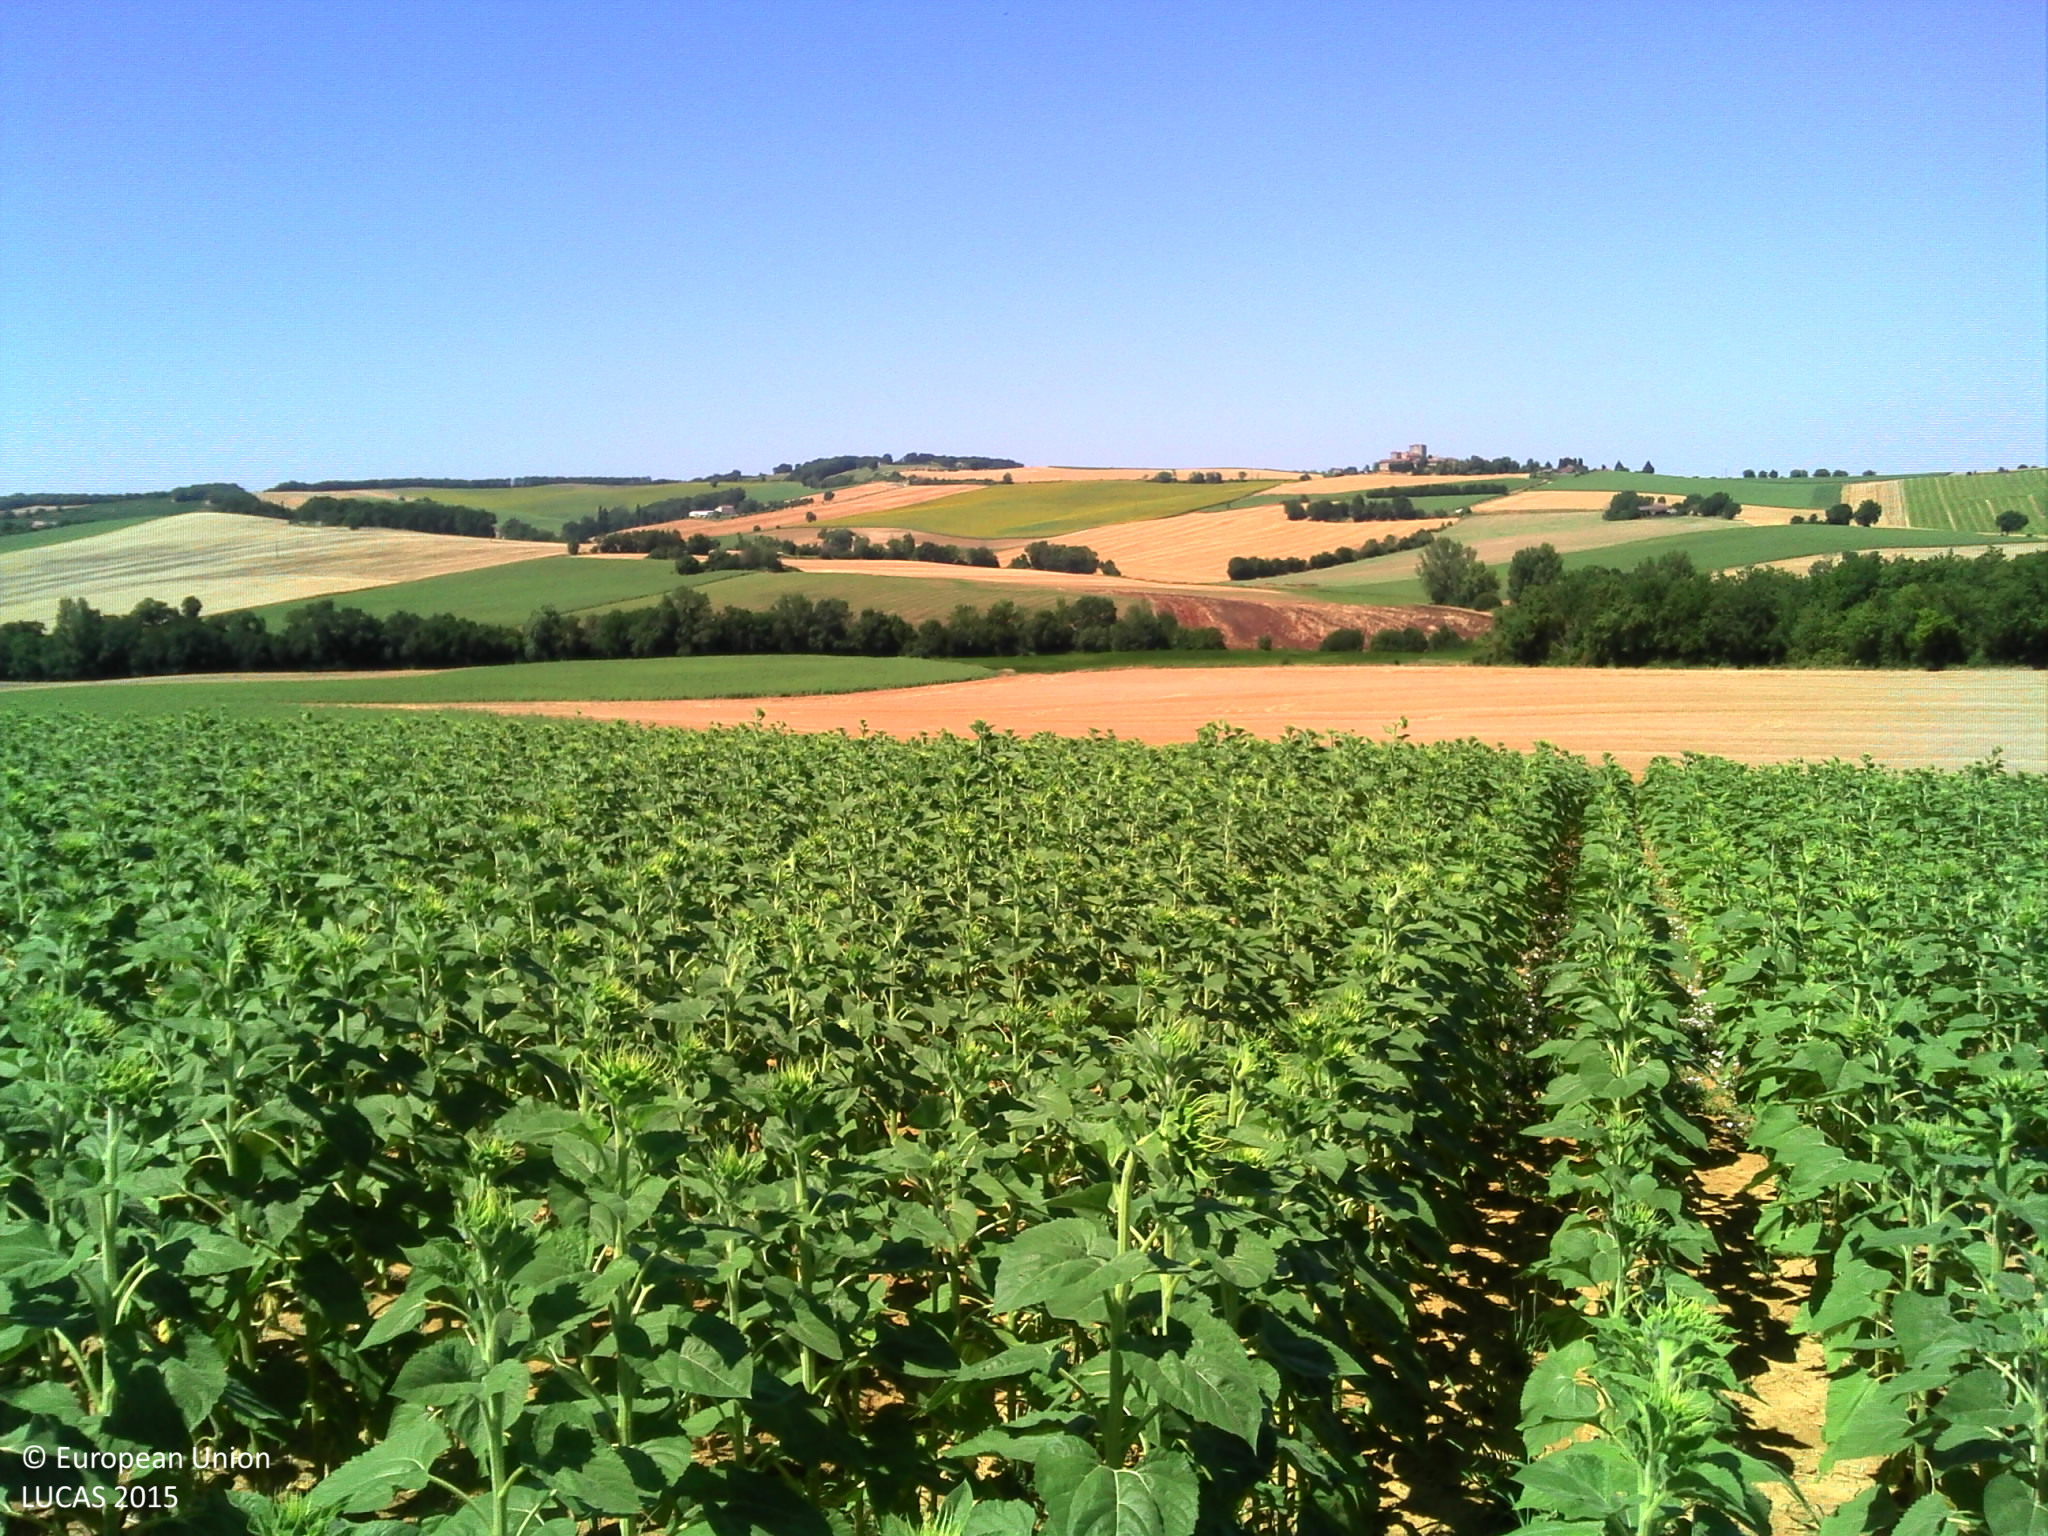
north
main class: Cropland
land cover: Sunflower
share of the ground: > 75 %
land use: Agriculture (excluding fallow land and kitchen gardens)
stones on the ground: < 10 %
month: July
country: FR
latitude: 44.0051
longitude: 0.7047
